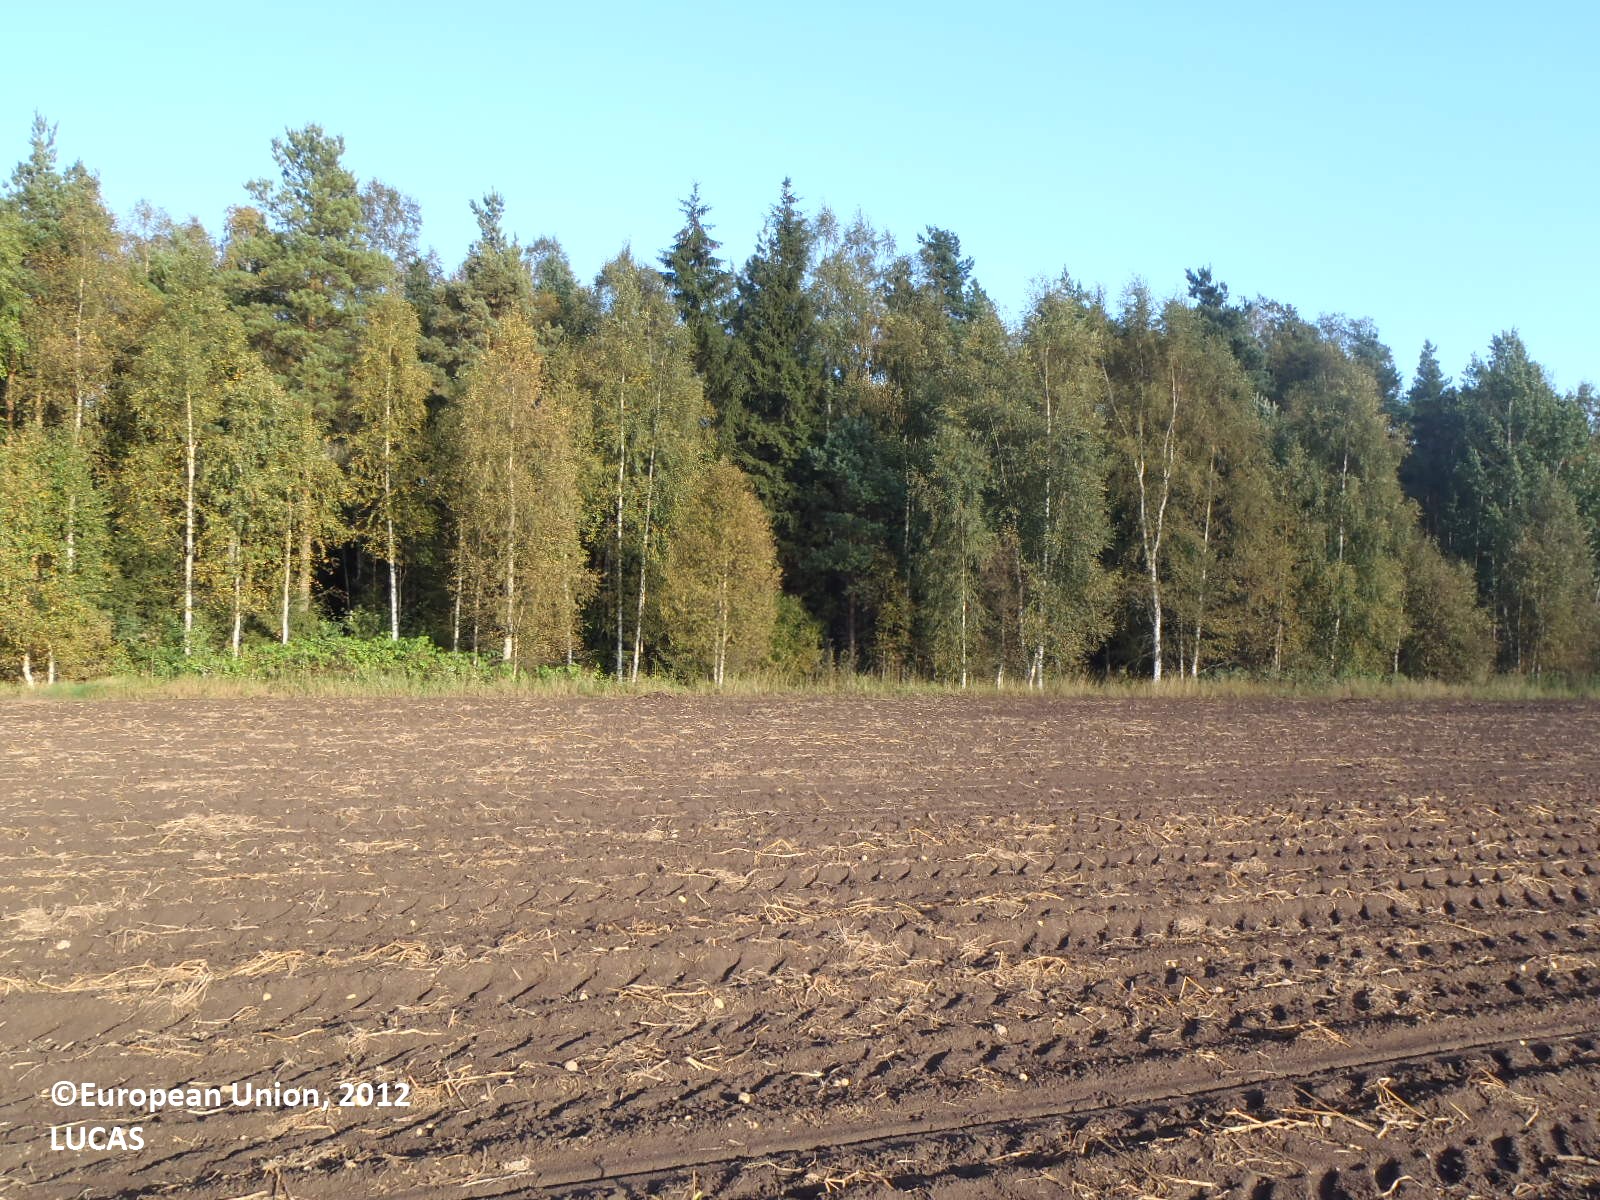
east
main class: Cropland
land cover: Potatoes
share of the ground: > 75 %
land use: Agriculture (excluding fallow land and kitchen gardens)
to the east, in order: Potatoes; Shrubland without tree cover; Ditches and canals; Pine dominated mixed woodland; Ditches and canals; Pine dominated mixed woodland; Ditches and canals; Pine dominated mixed woodland; Ditches and canals; Pine dominated mixed woodland; Ditches and canals; Pine dominated mixed woodland
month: September
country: FI
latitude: 61.0796
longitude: 22.5426
